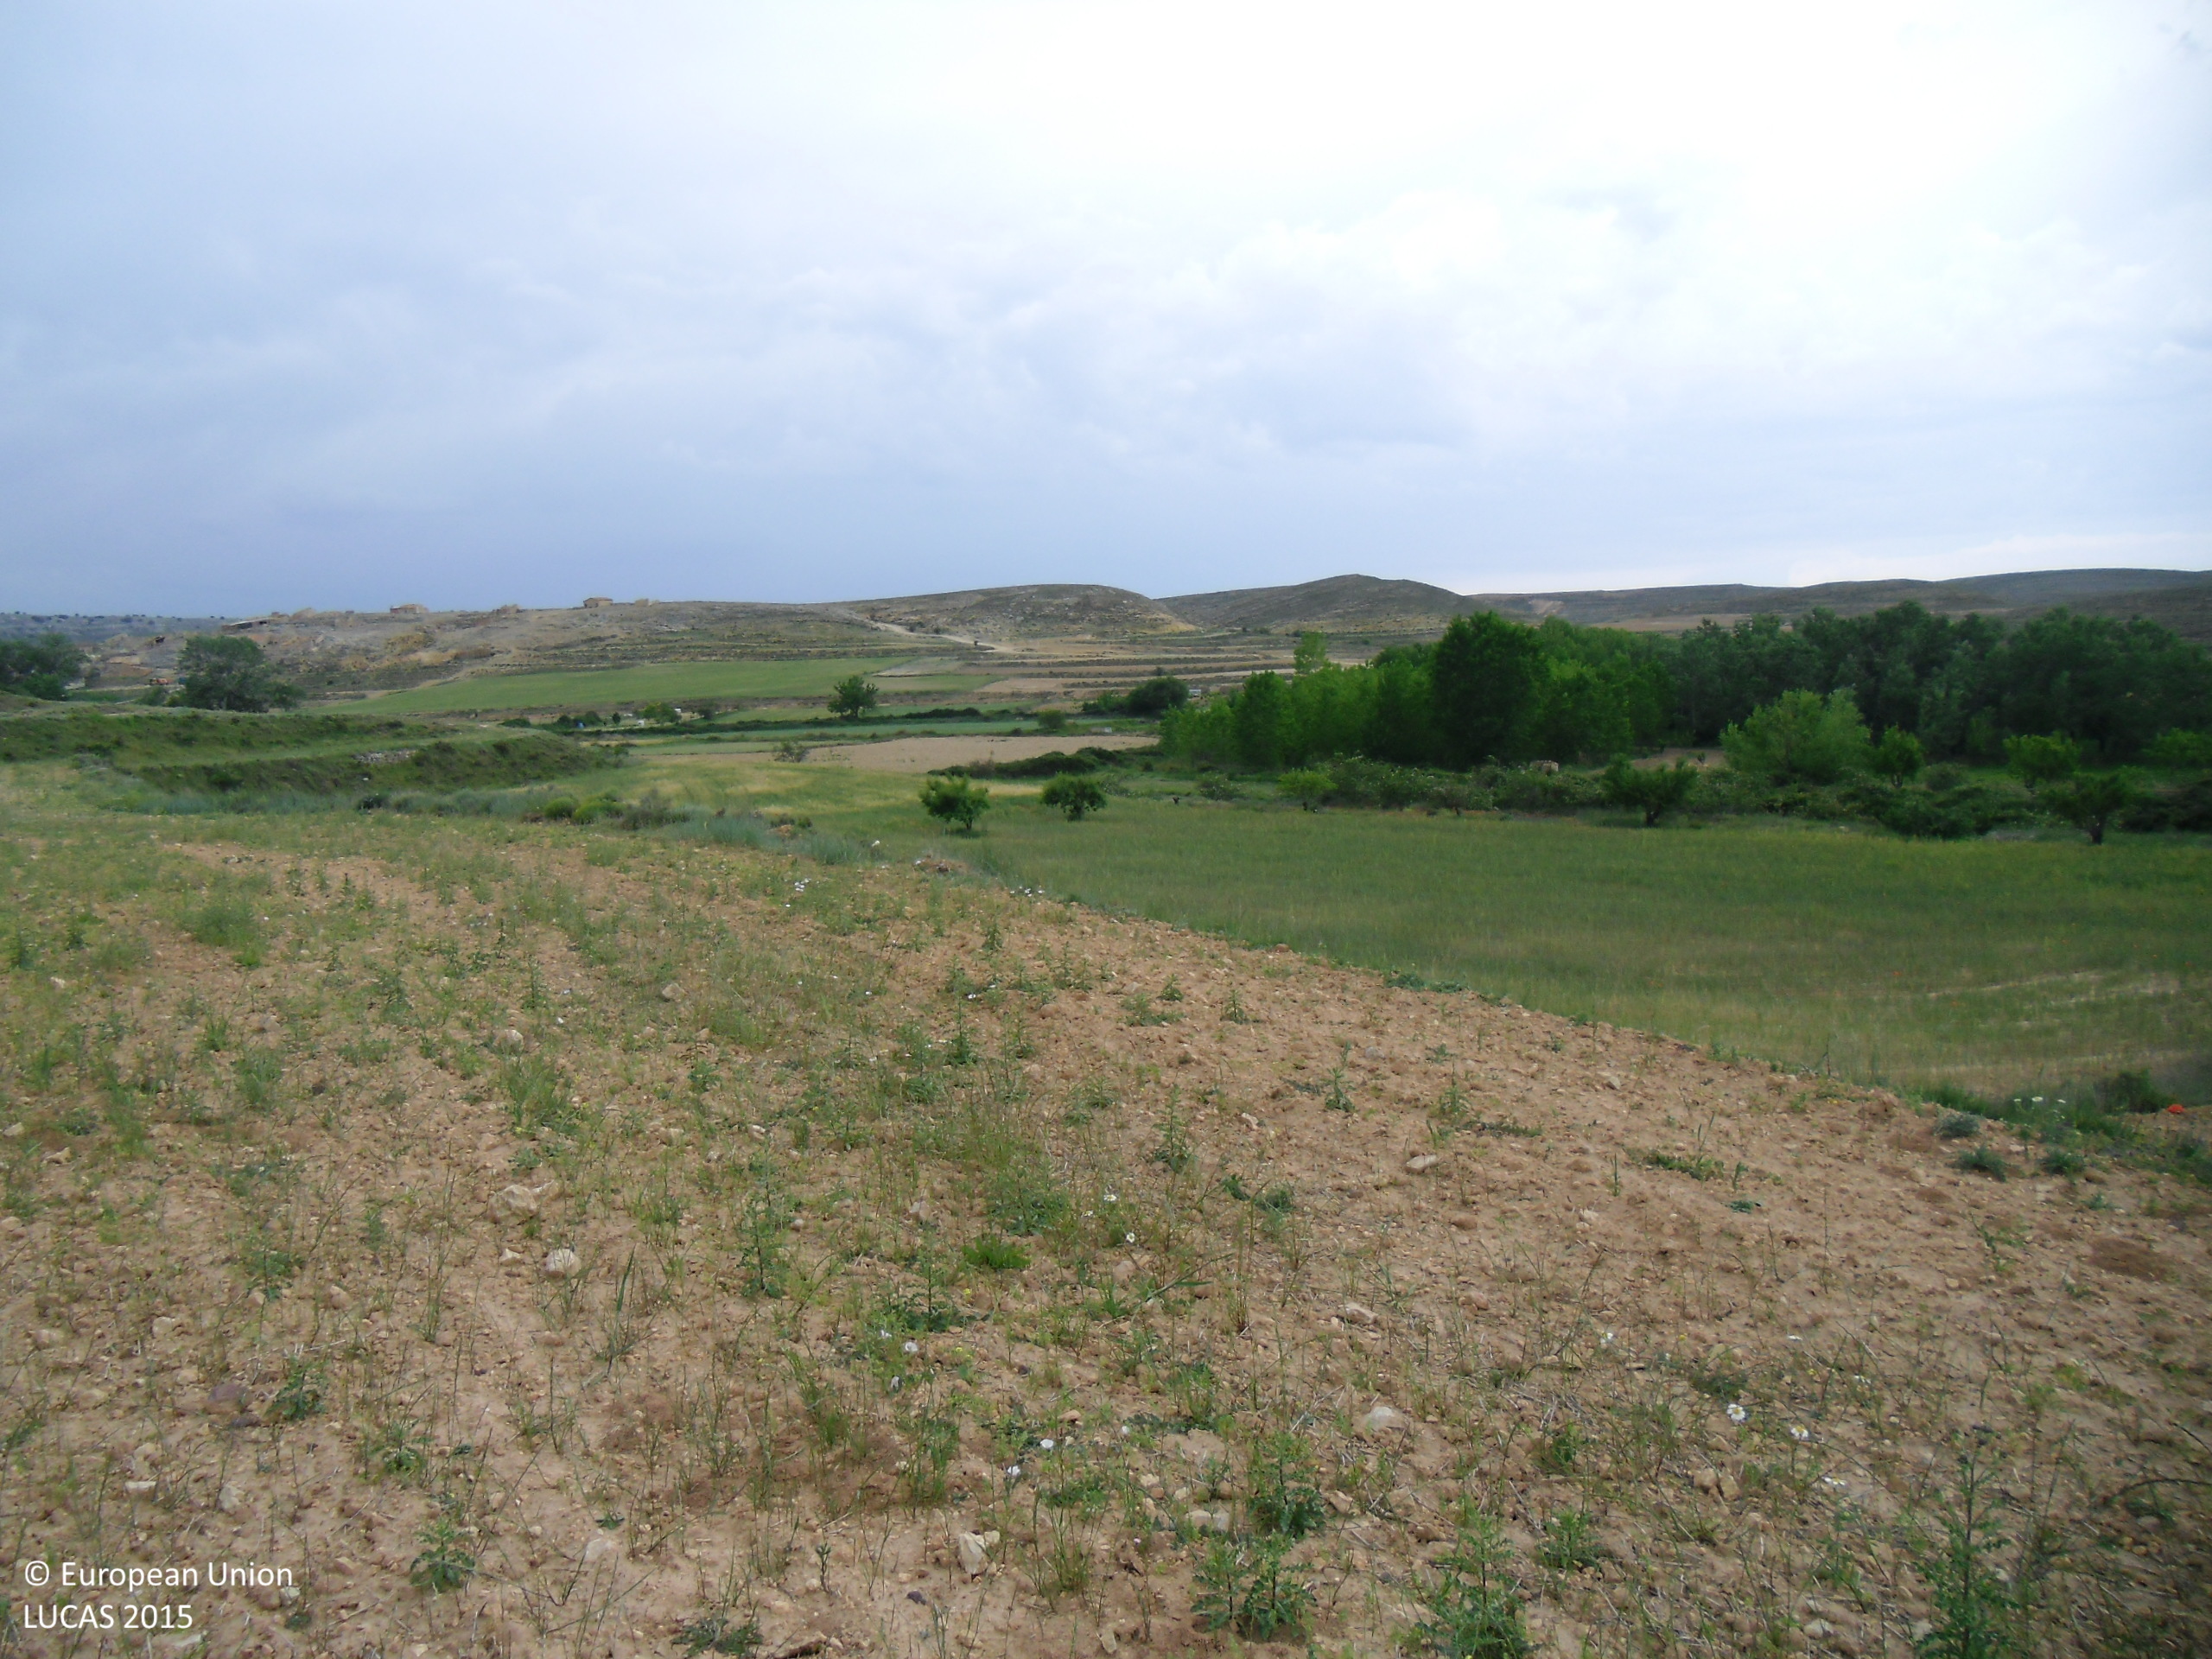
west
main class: Grassland
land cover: Spontaneously vegetated surfaces
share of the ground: 25 - 50 %
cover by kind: unconsolidated bare surface 60 %, herbaceous plants 40 %
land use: Fallow land
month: May
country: ES
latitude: 40.9953
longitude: -0.8450
